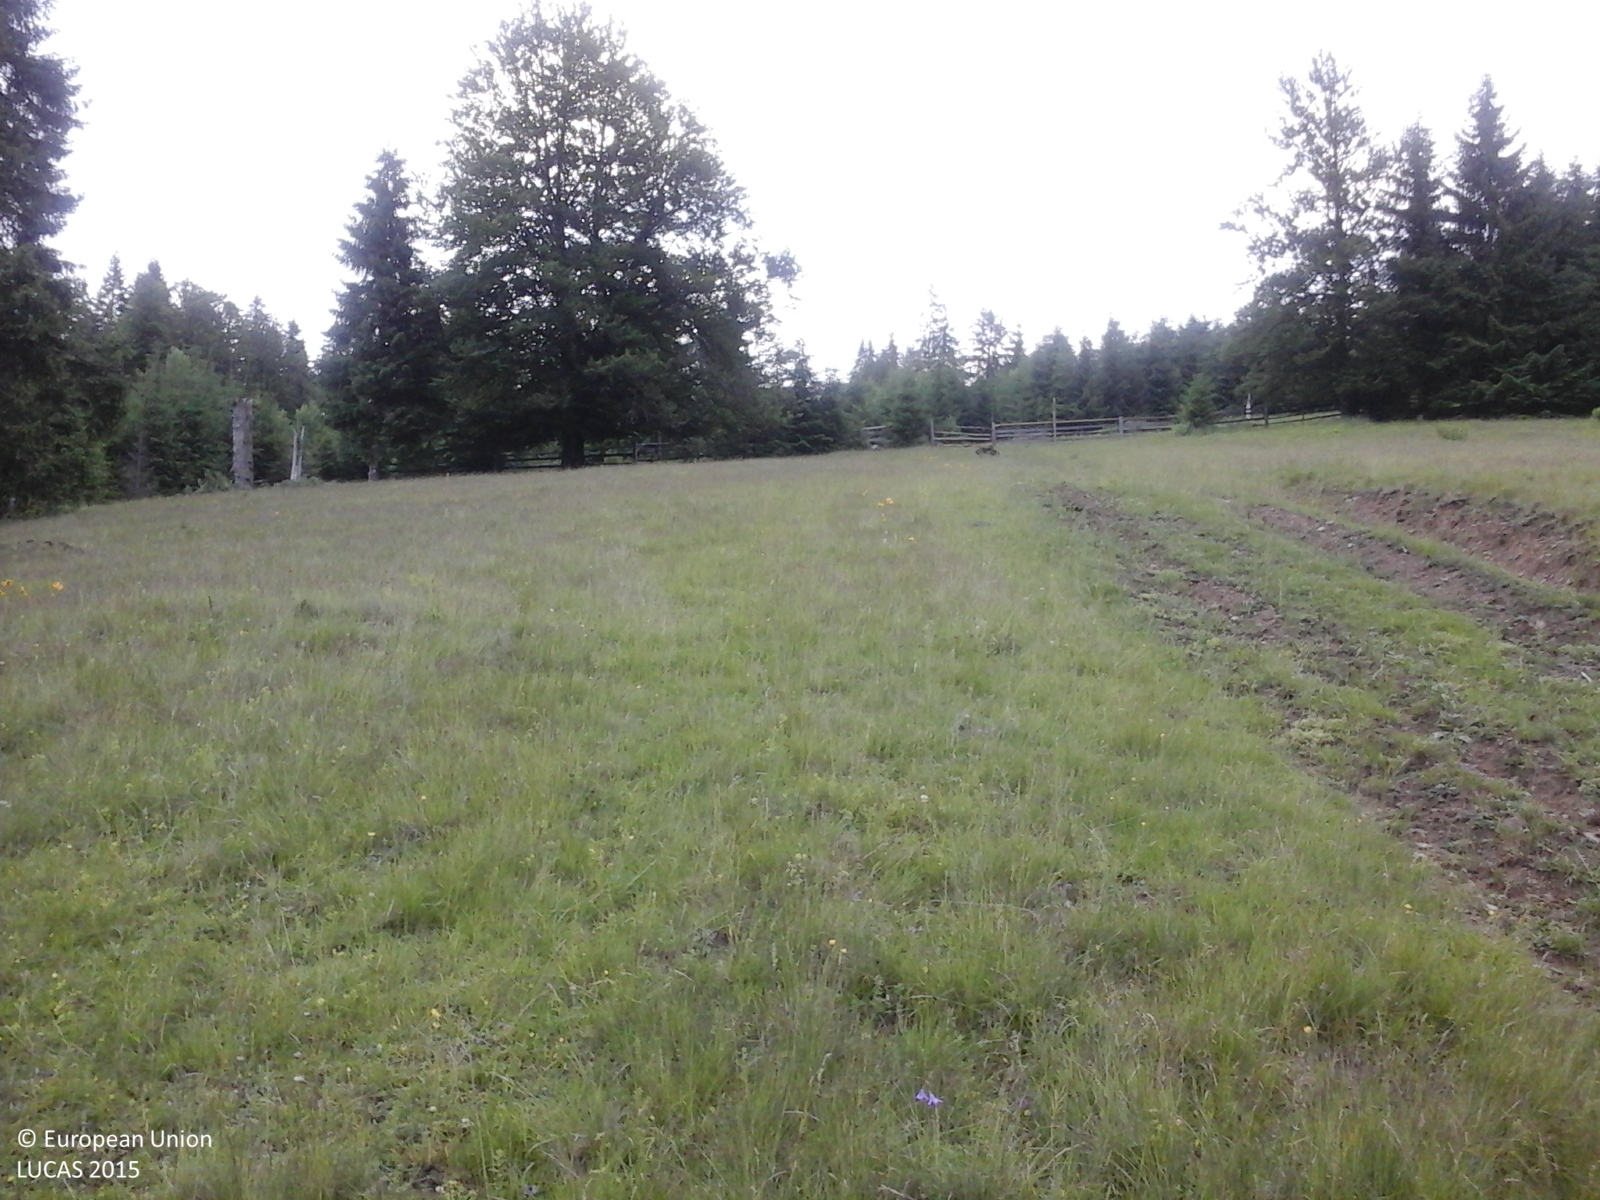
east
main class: Grassland
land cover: Grassland without tree/shrub cover
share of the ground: > 75 %
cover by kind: herbaceous plants 100 %
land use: Agriculture (excluding fallow land and kitchen gardens)
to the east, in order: Grassland without tree/shrub cover; Lines of trees; Fences; Grassland without tree/shrub cover; Lines of trees; Grassland without tree/shrub cover; Spruce dominated coniferous woodland; Fences; Spruce dominated coniferous woodland; Fences; Spruce dominated coniferous woodland; Grassland without tree/shrub cover
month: June
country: RO
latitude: 47.3754
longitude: 25.1115
